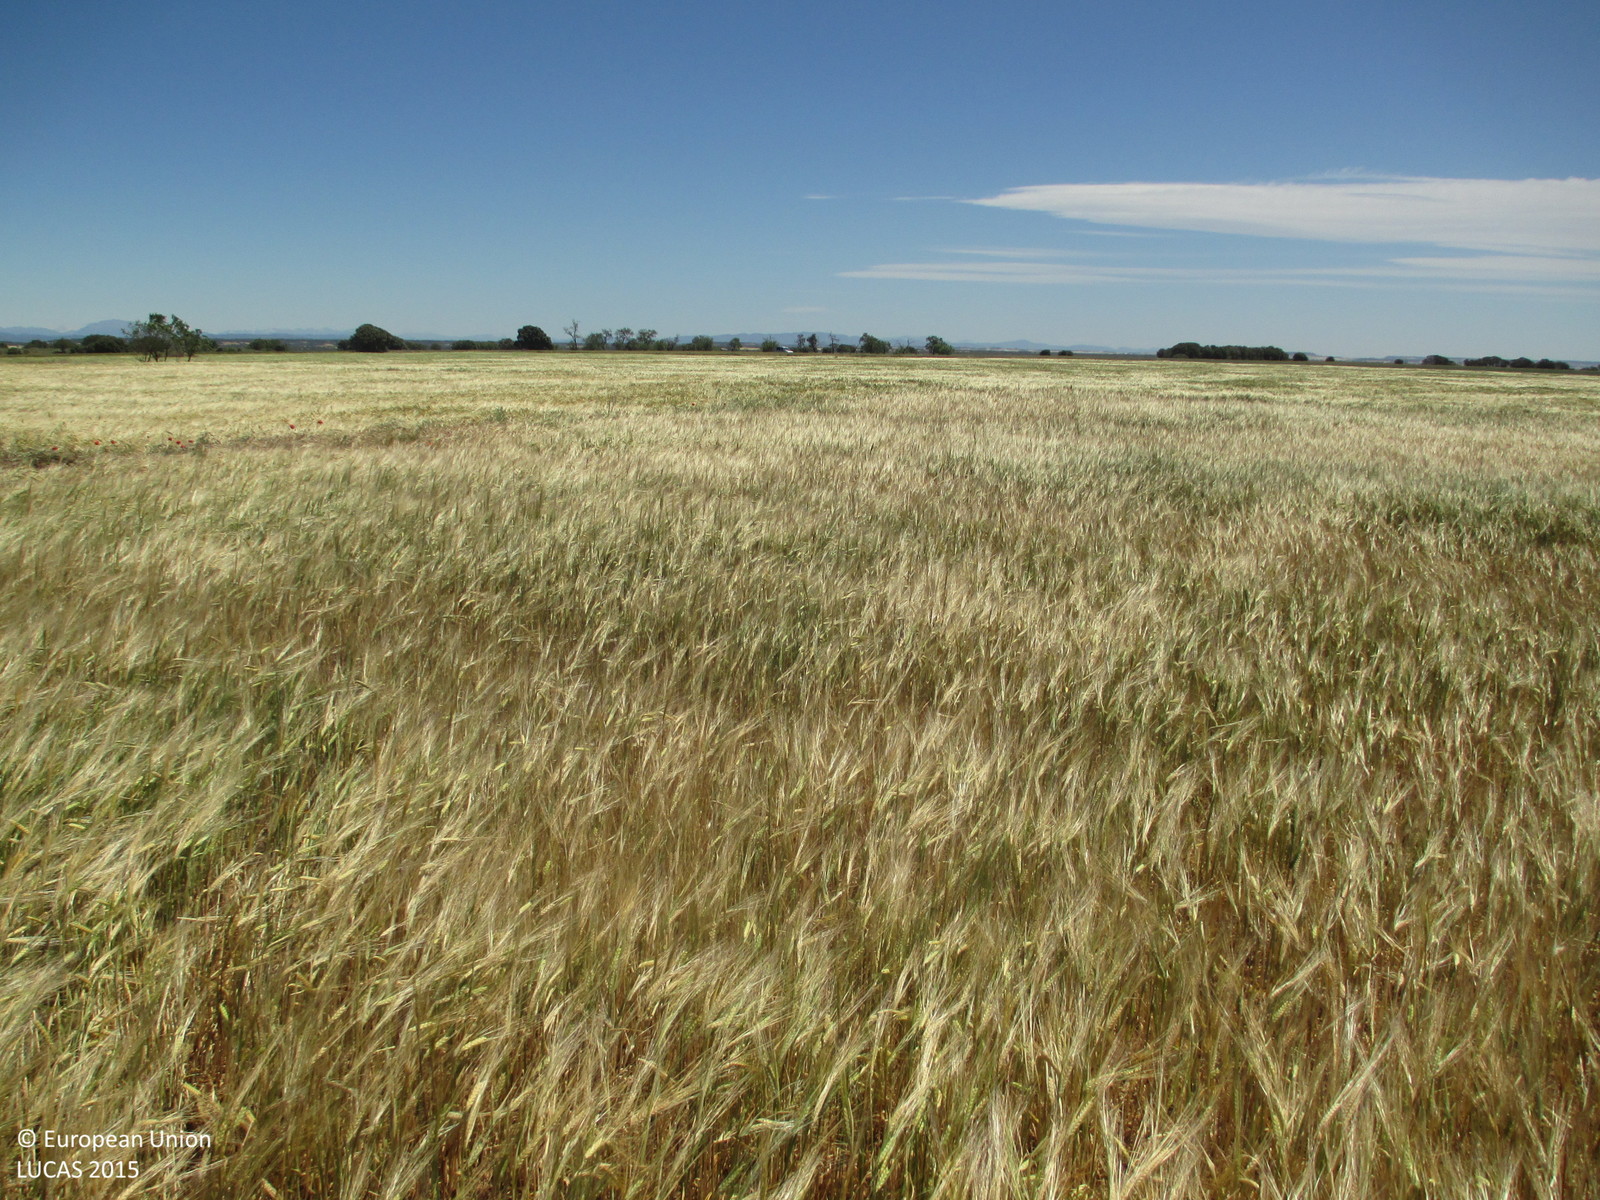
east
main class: Cropland
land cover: Barley
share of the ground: > 75 %
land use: Agriculture (excluding fallow land and kitchen gardens)
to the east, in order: Barley; Shruby margins; Barley; Dry stone walls; Common wheat; Tracks; Dry stone walls; Common wheat
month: May
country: ES
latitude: 42.0032
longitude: -0.2708
